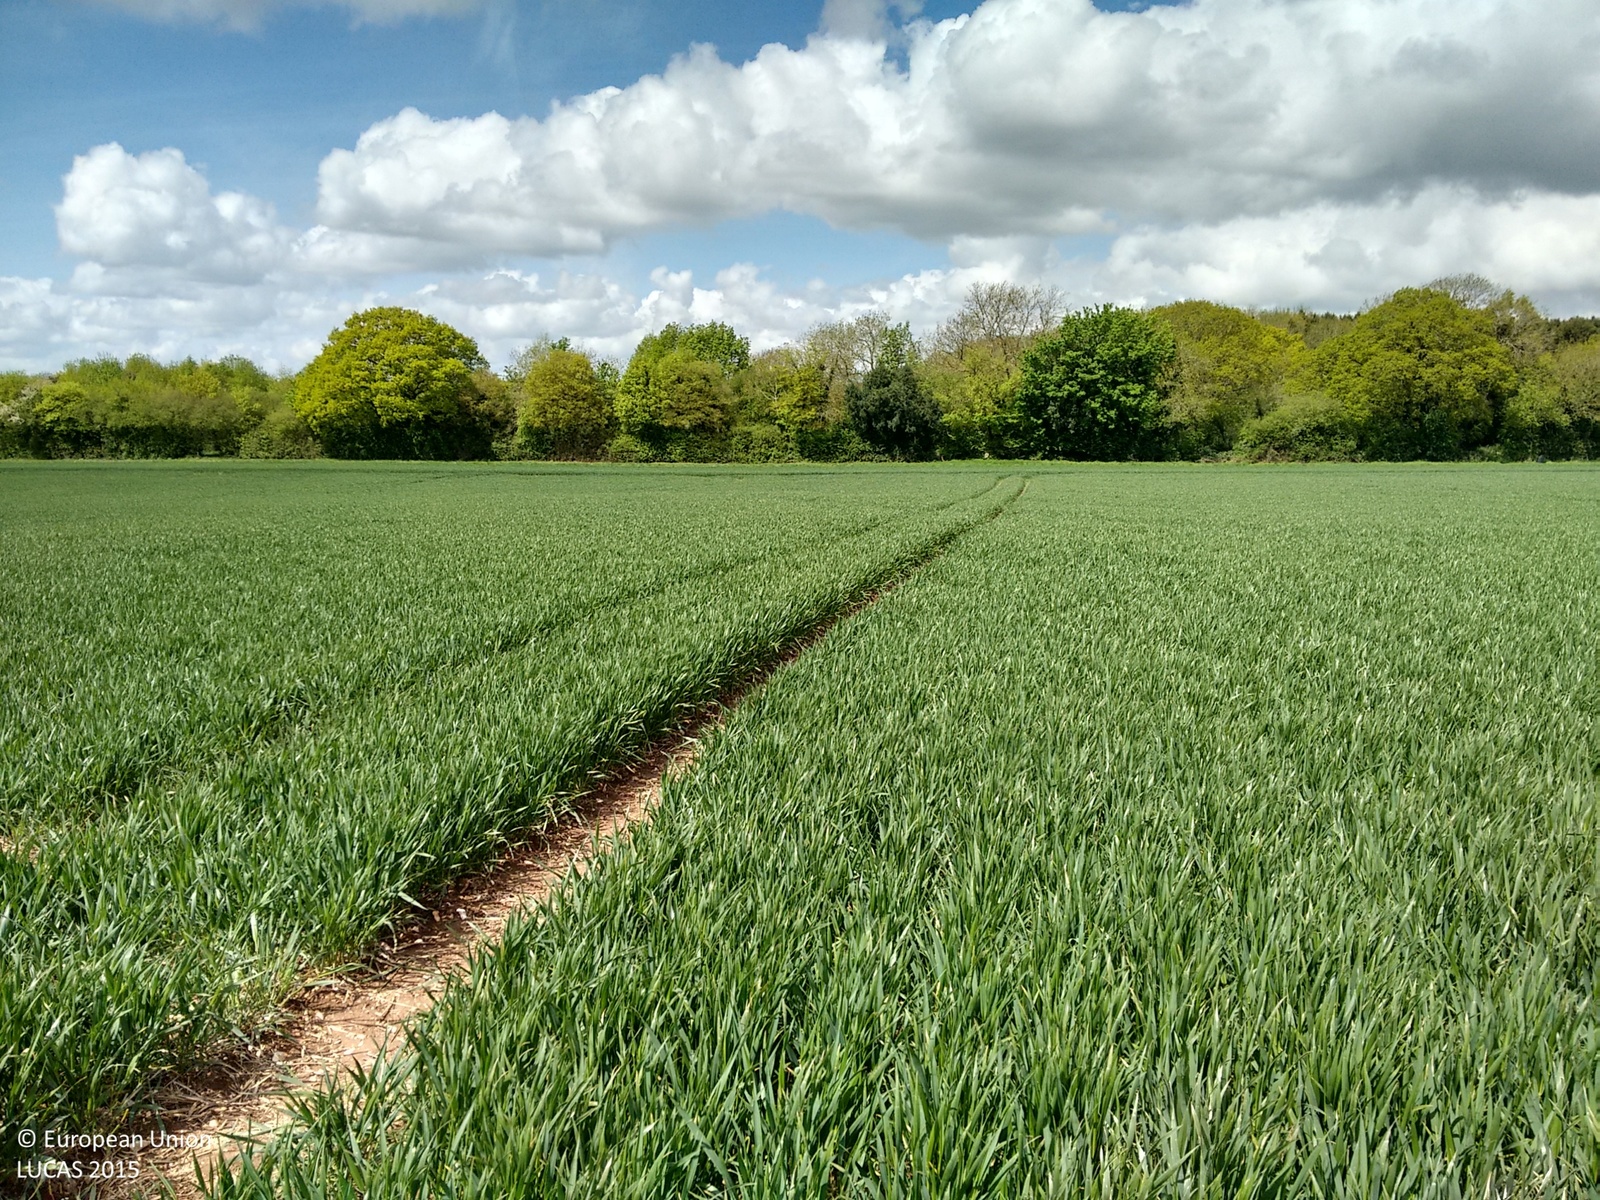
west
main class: Cropland
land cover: Common wheat
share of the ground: > 75 %
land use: Agriculture (excluding fallow land and kitchen gardens)
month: May
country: GB
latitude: 51.2328
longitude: -1.5231
